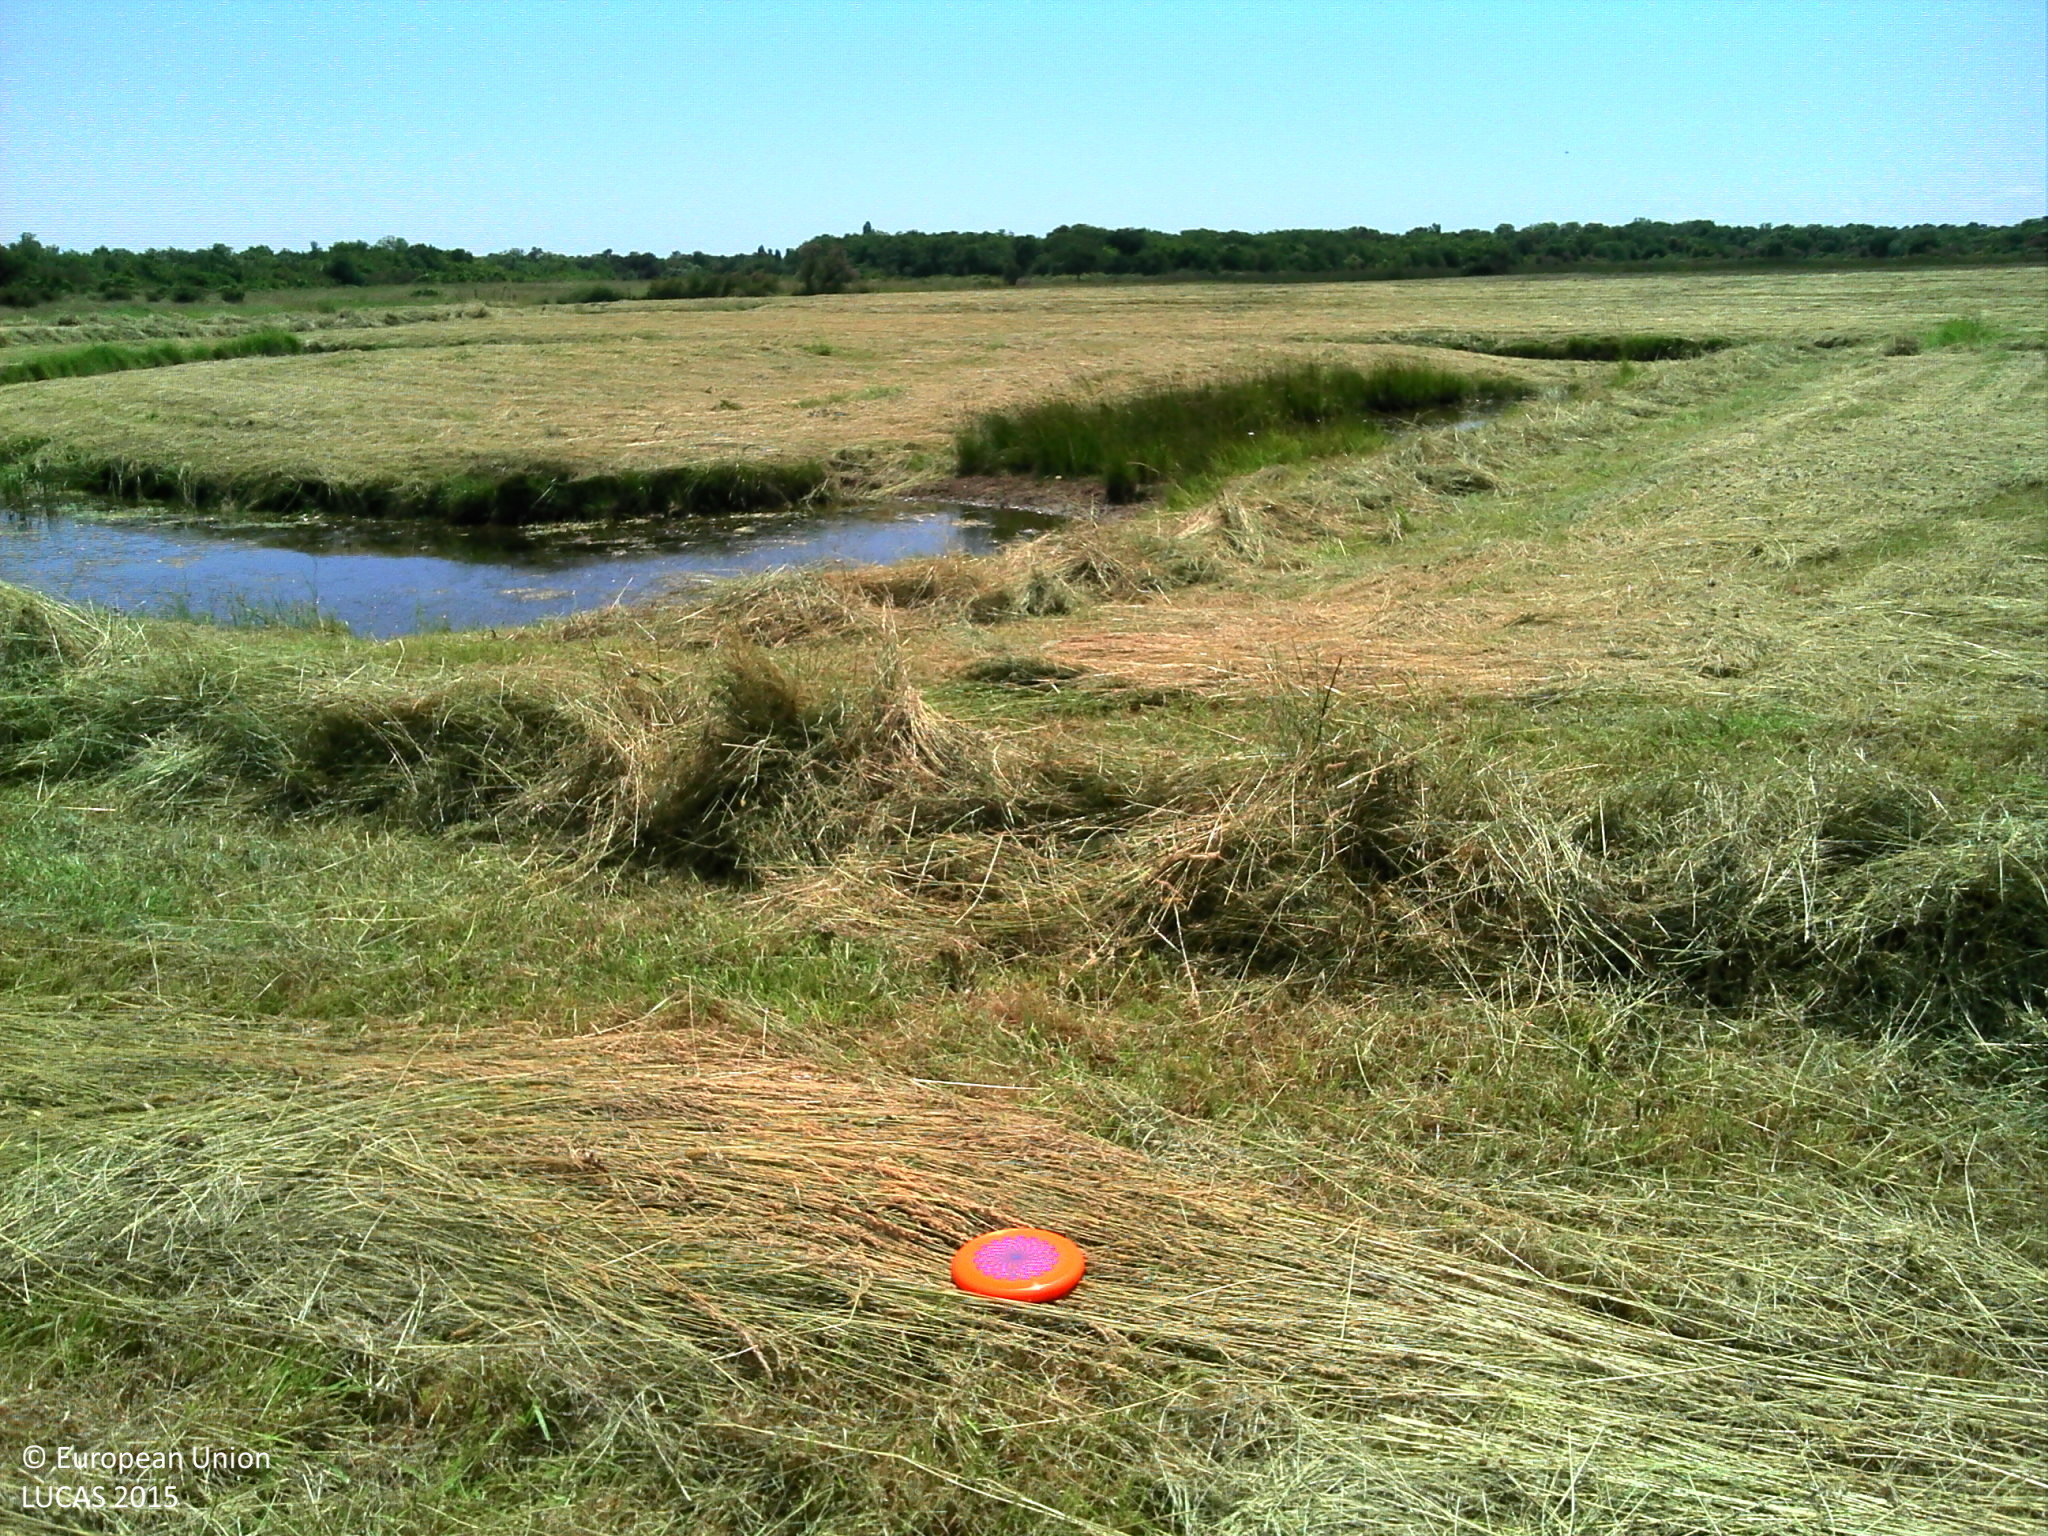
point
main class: Grassland
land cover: Grassland without tree/shrub cover
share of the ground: > 75 %
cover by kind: herbaceous plants 100 %
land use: Agriculture (excluding fallow land and kitchen gardens)
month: May
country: FR
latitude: 45.9358
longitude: -1.2657
